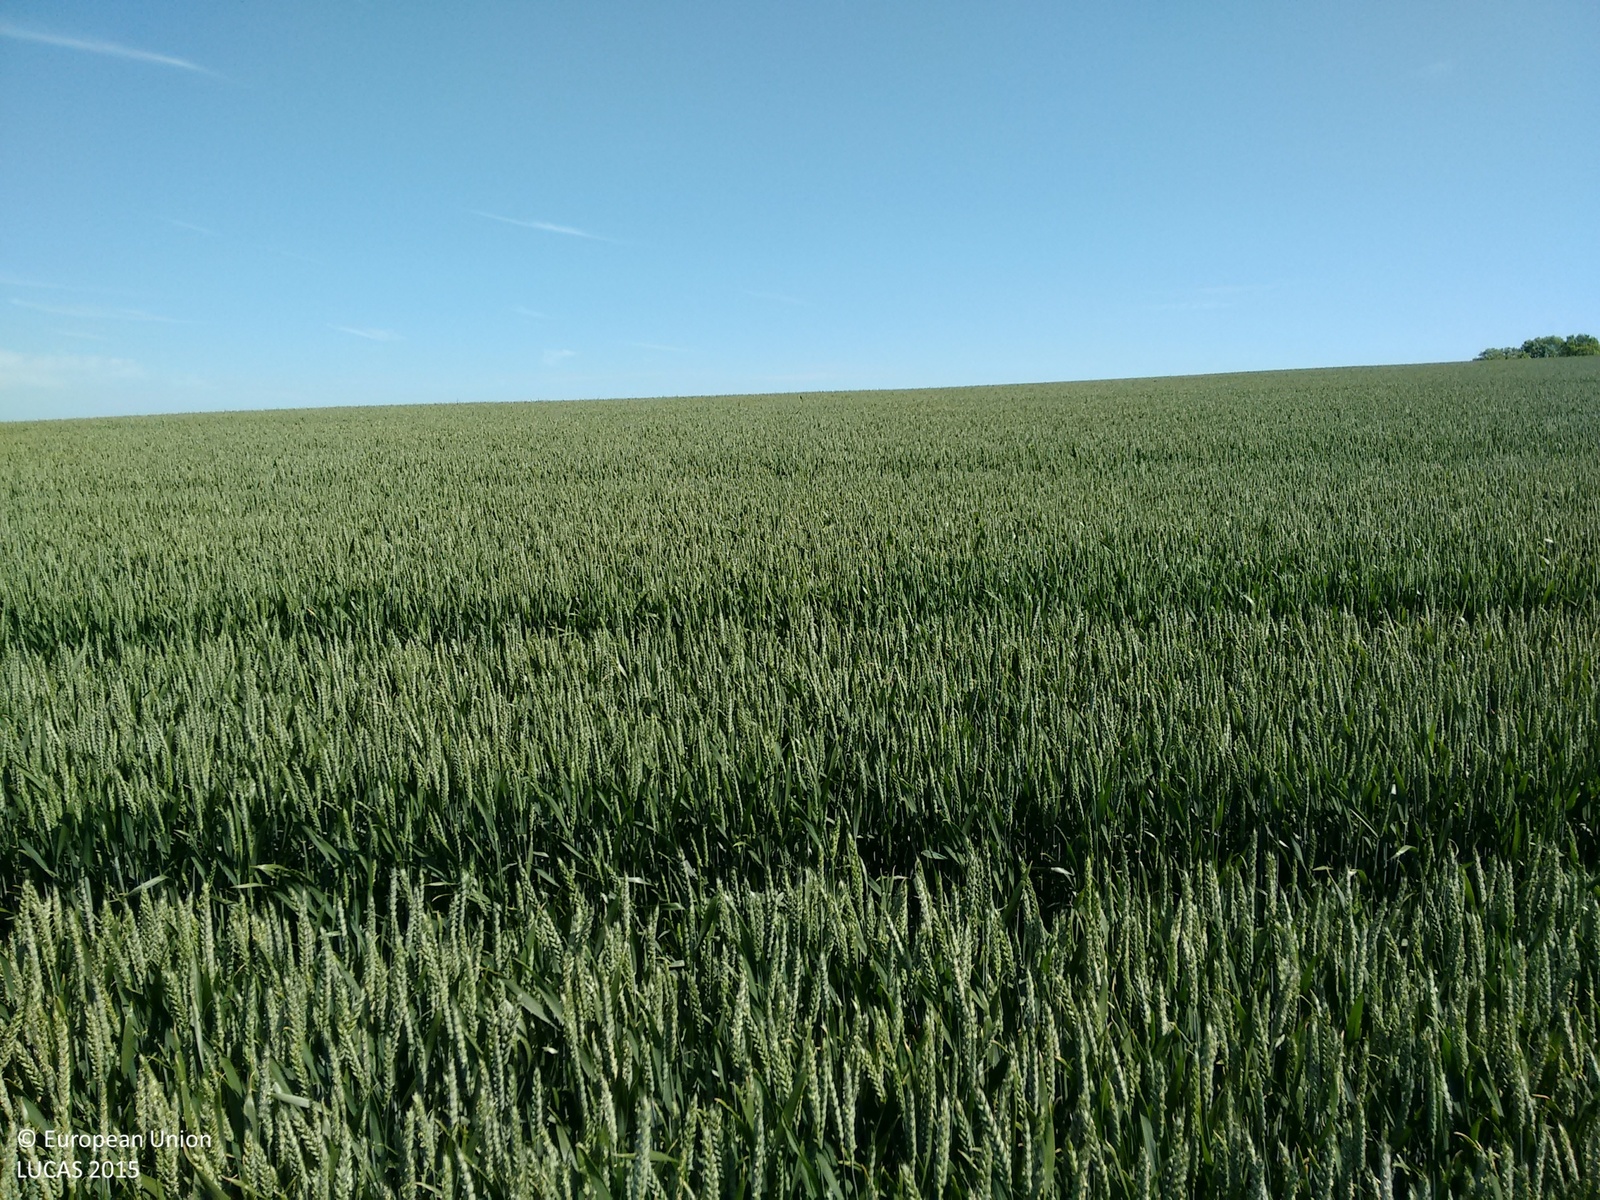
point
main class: Cropland
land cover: Common wheat
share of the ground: > 75 %
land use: Agriculture (excluding fallow land and kitchen gardens)
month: June
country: GB
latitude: 51.0381
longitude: 0.7473
